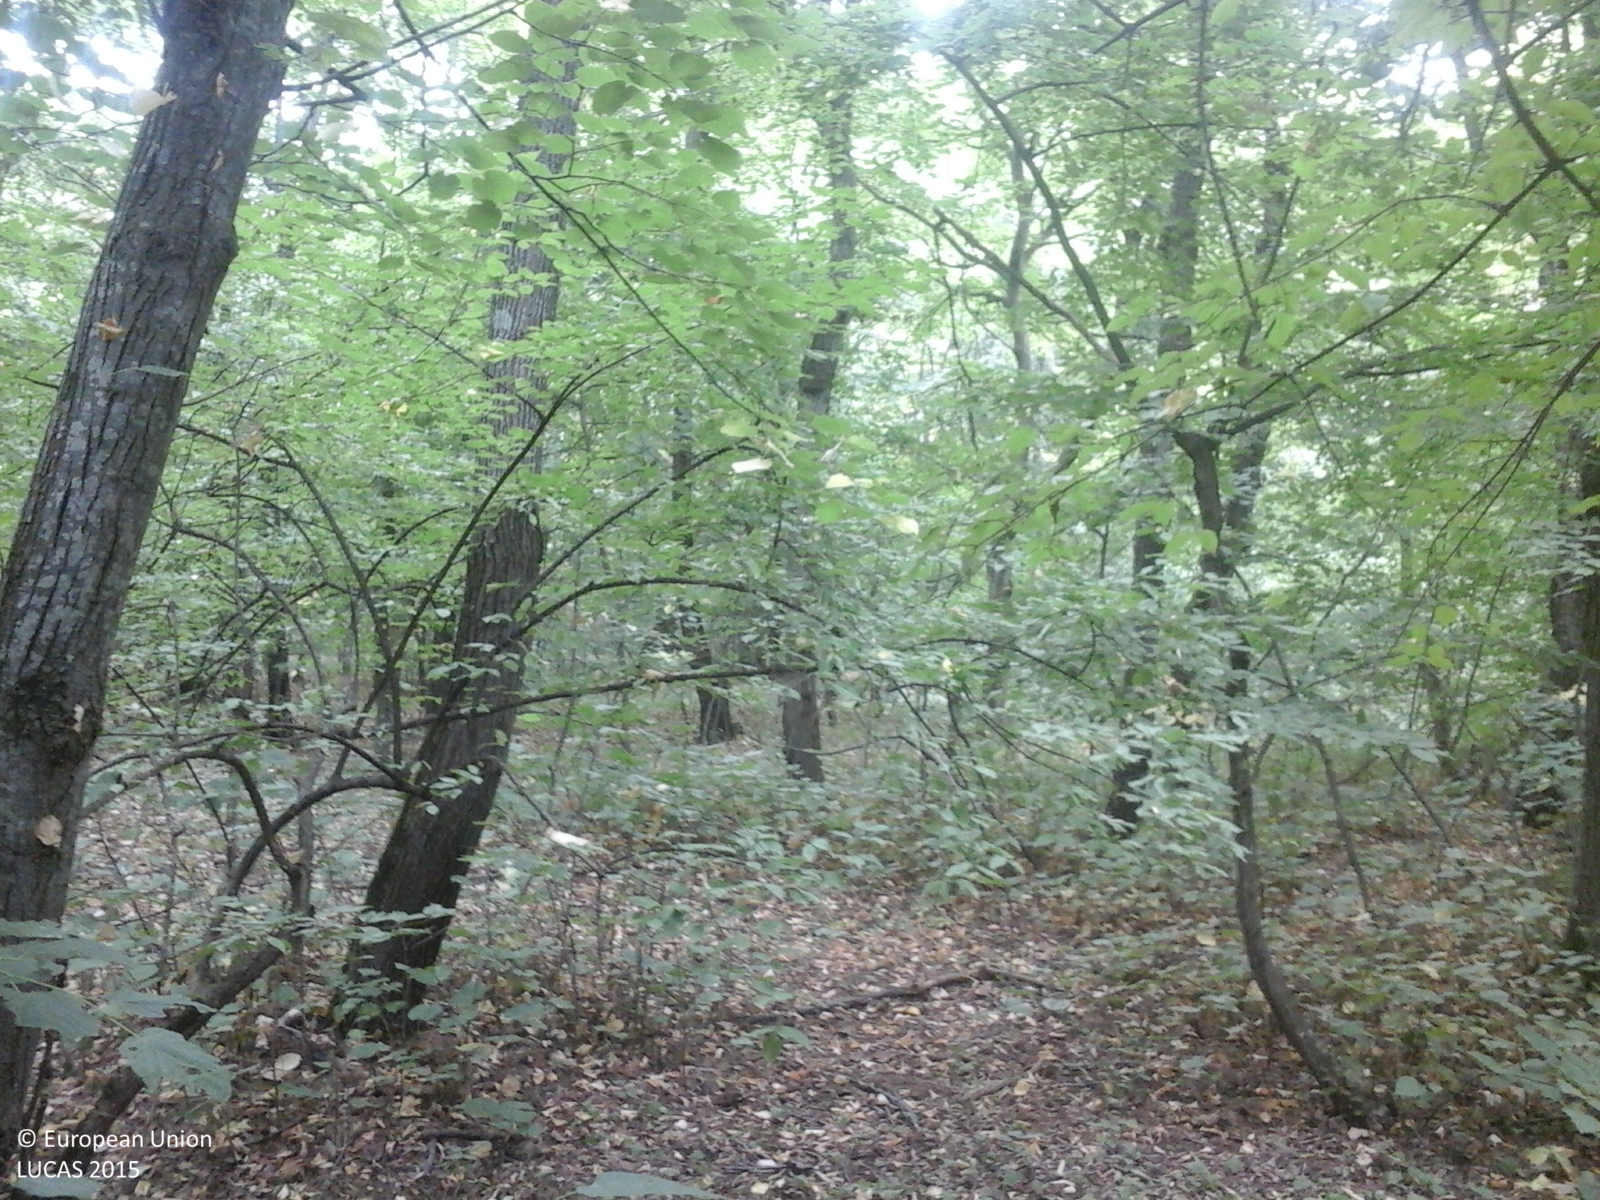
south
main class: Woodland
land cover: Broadleaved woodland
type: mesophytic deciduous forest
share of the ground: > 75 %
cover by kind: broadleaved forest trees 100 %
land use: Forestry
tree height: > 5 m
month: July
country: RO
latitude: 45.2559
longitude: 28.3881
